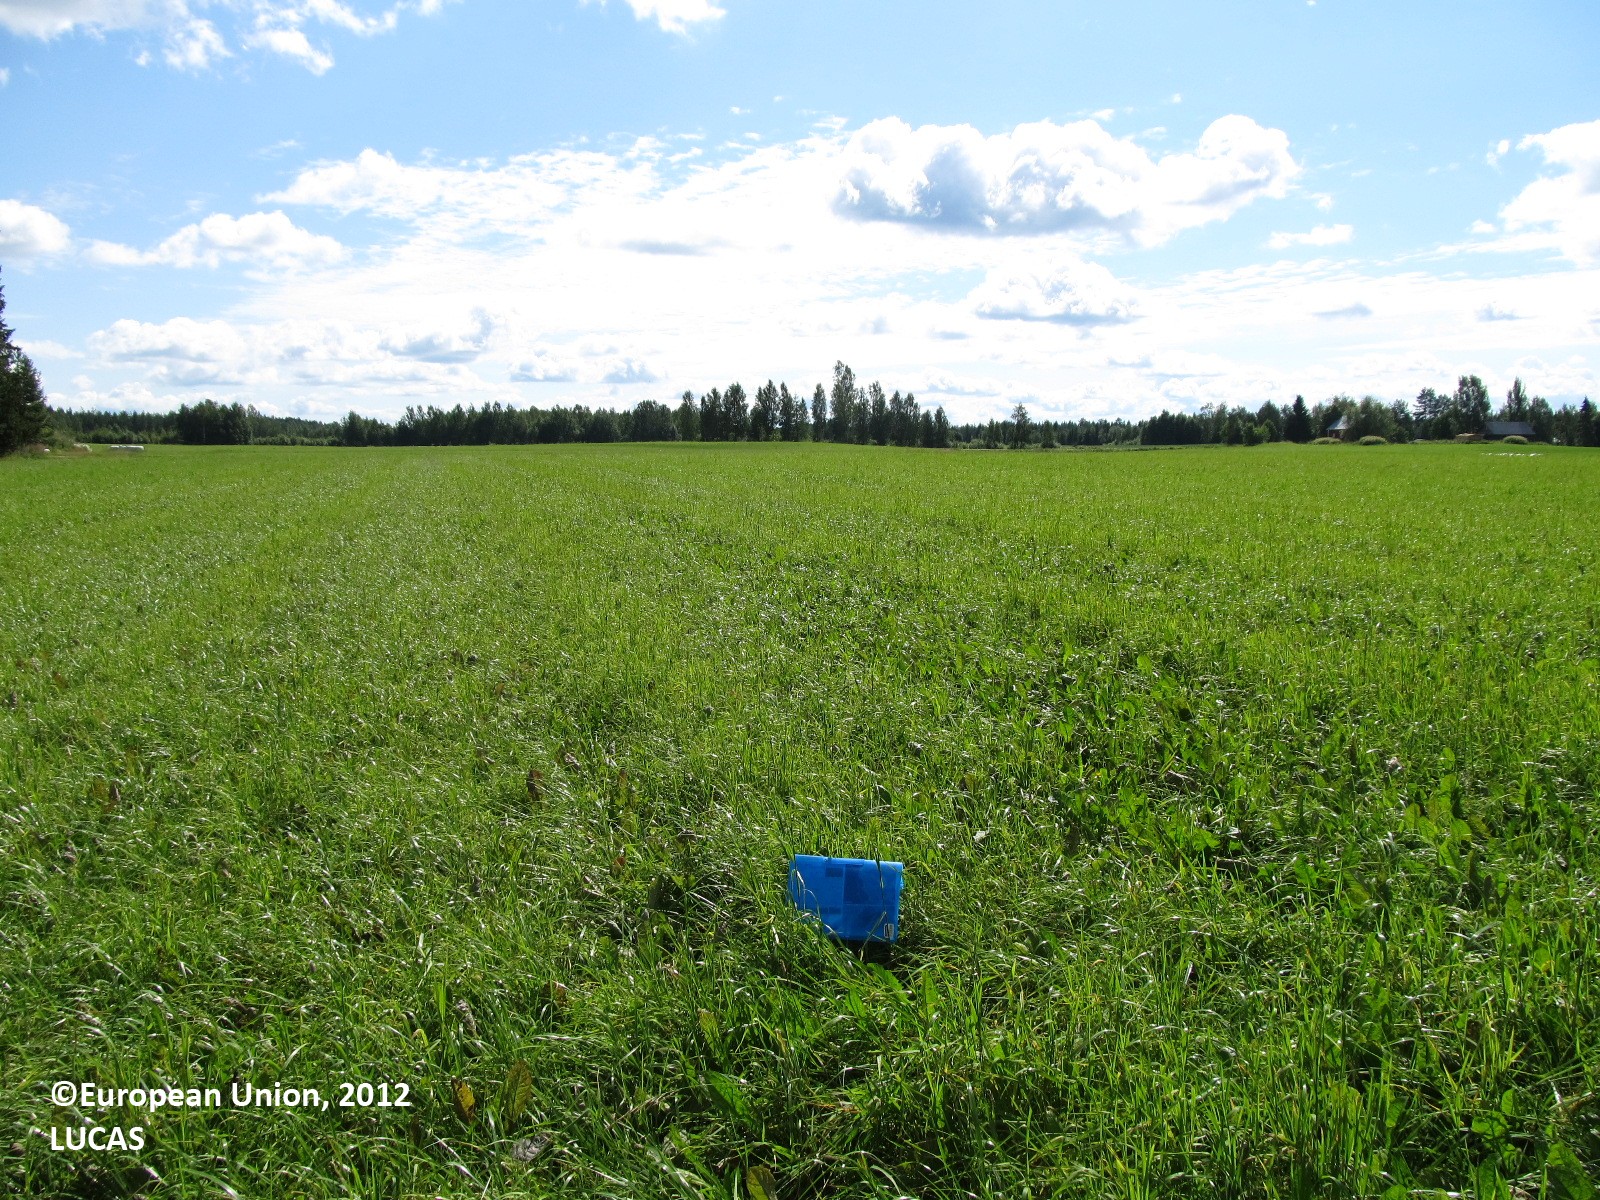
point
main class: Cropland
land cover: Temporary grasslands
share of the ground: 50 - 75 %
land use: Agriculture (excluding fallow land and kitchen gardens)
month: July
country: FI
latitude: 62.0567
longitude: 27.9583
